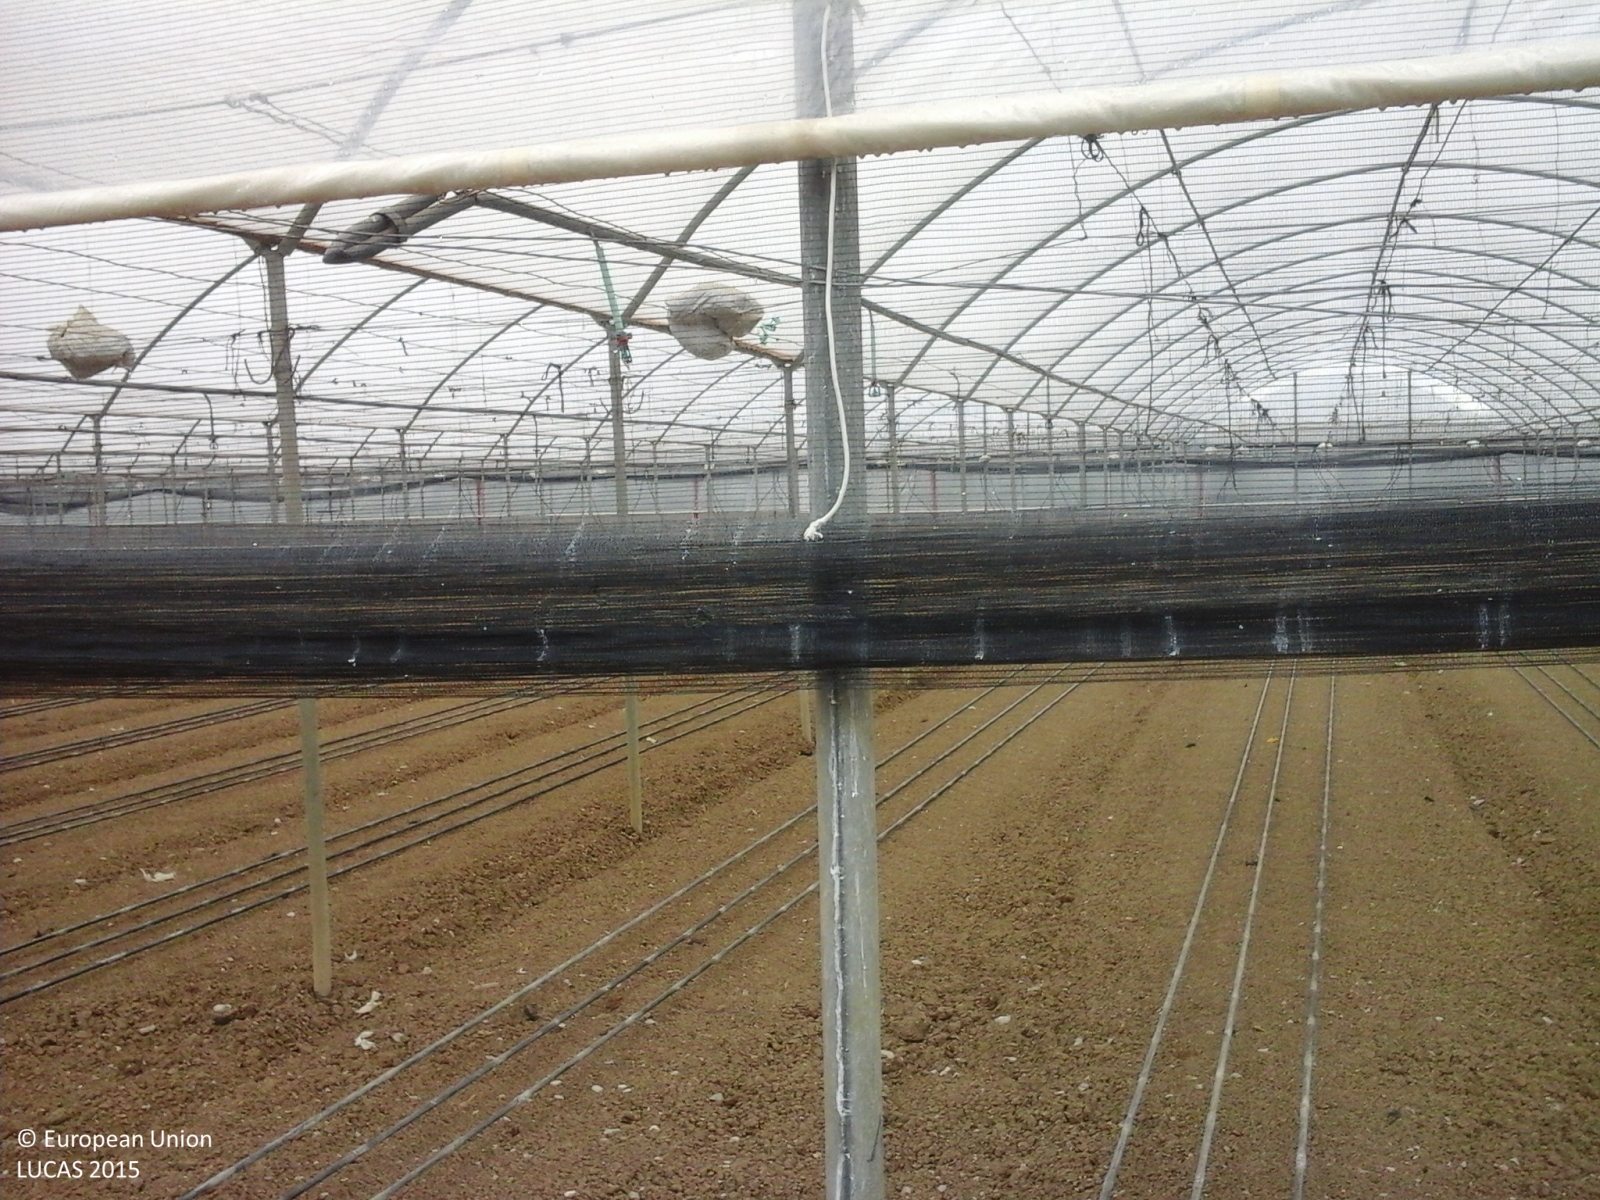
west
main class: Artificial land
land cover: Greenhouses
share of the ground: > 75 %
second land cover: Other fresh vegetables
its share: > 75 %
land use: Agriculture (excluding fallow land and kitchen gardens)
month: May
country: IT
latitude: 40.5725
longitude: 15.0465
